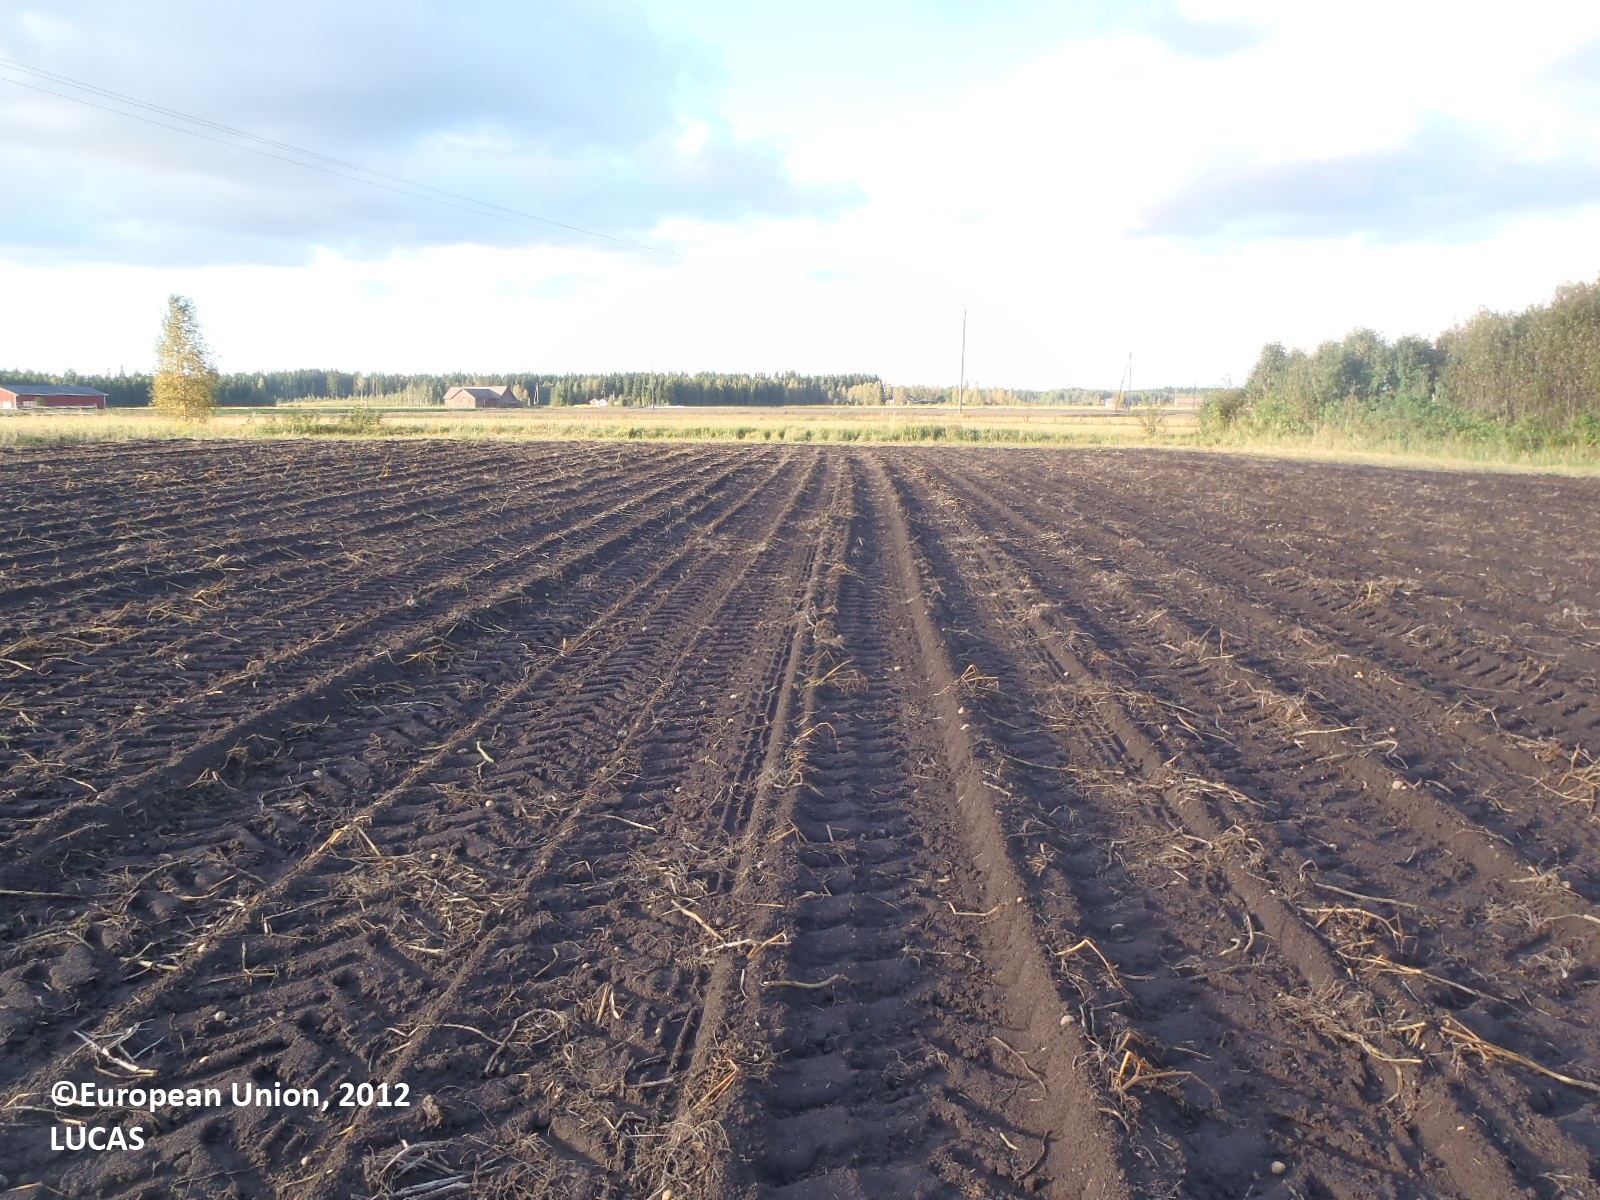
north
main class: Cropland
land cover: Potatoes
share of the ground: > 75 %
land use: Agriculture (excluding fallow land and kitchen gardens)
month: September
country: FI
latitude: 61.0796
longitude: 22.5426
